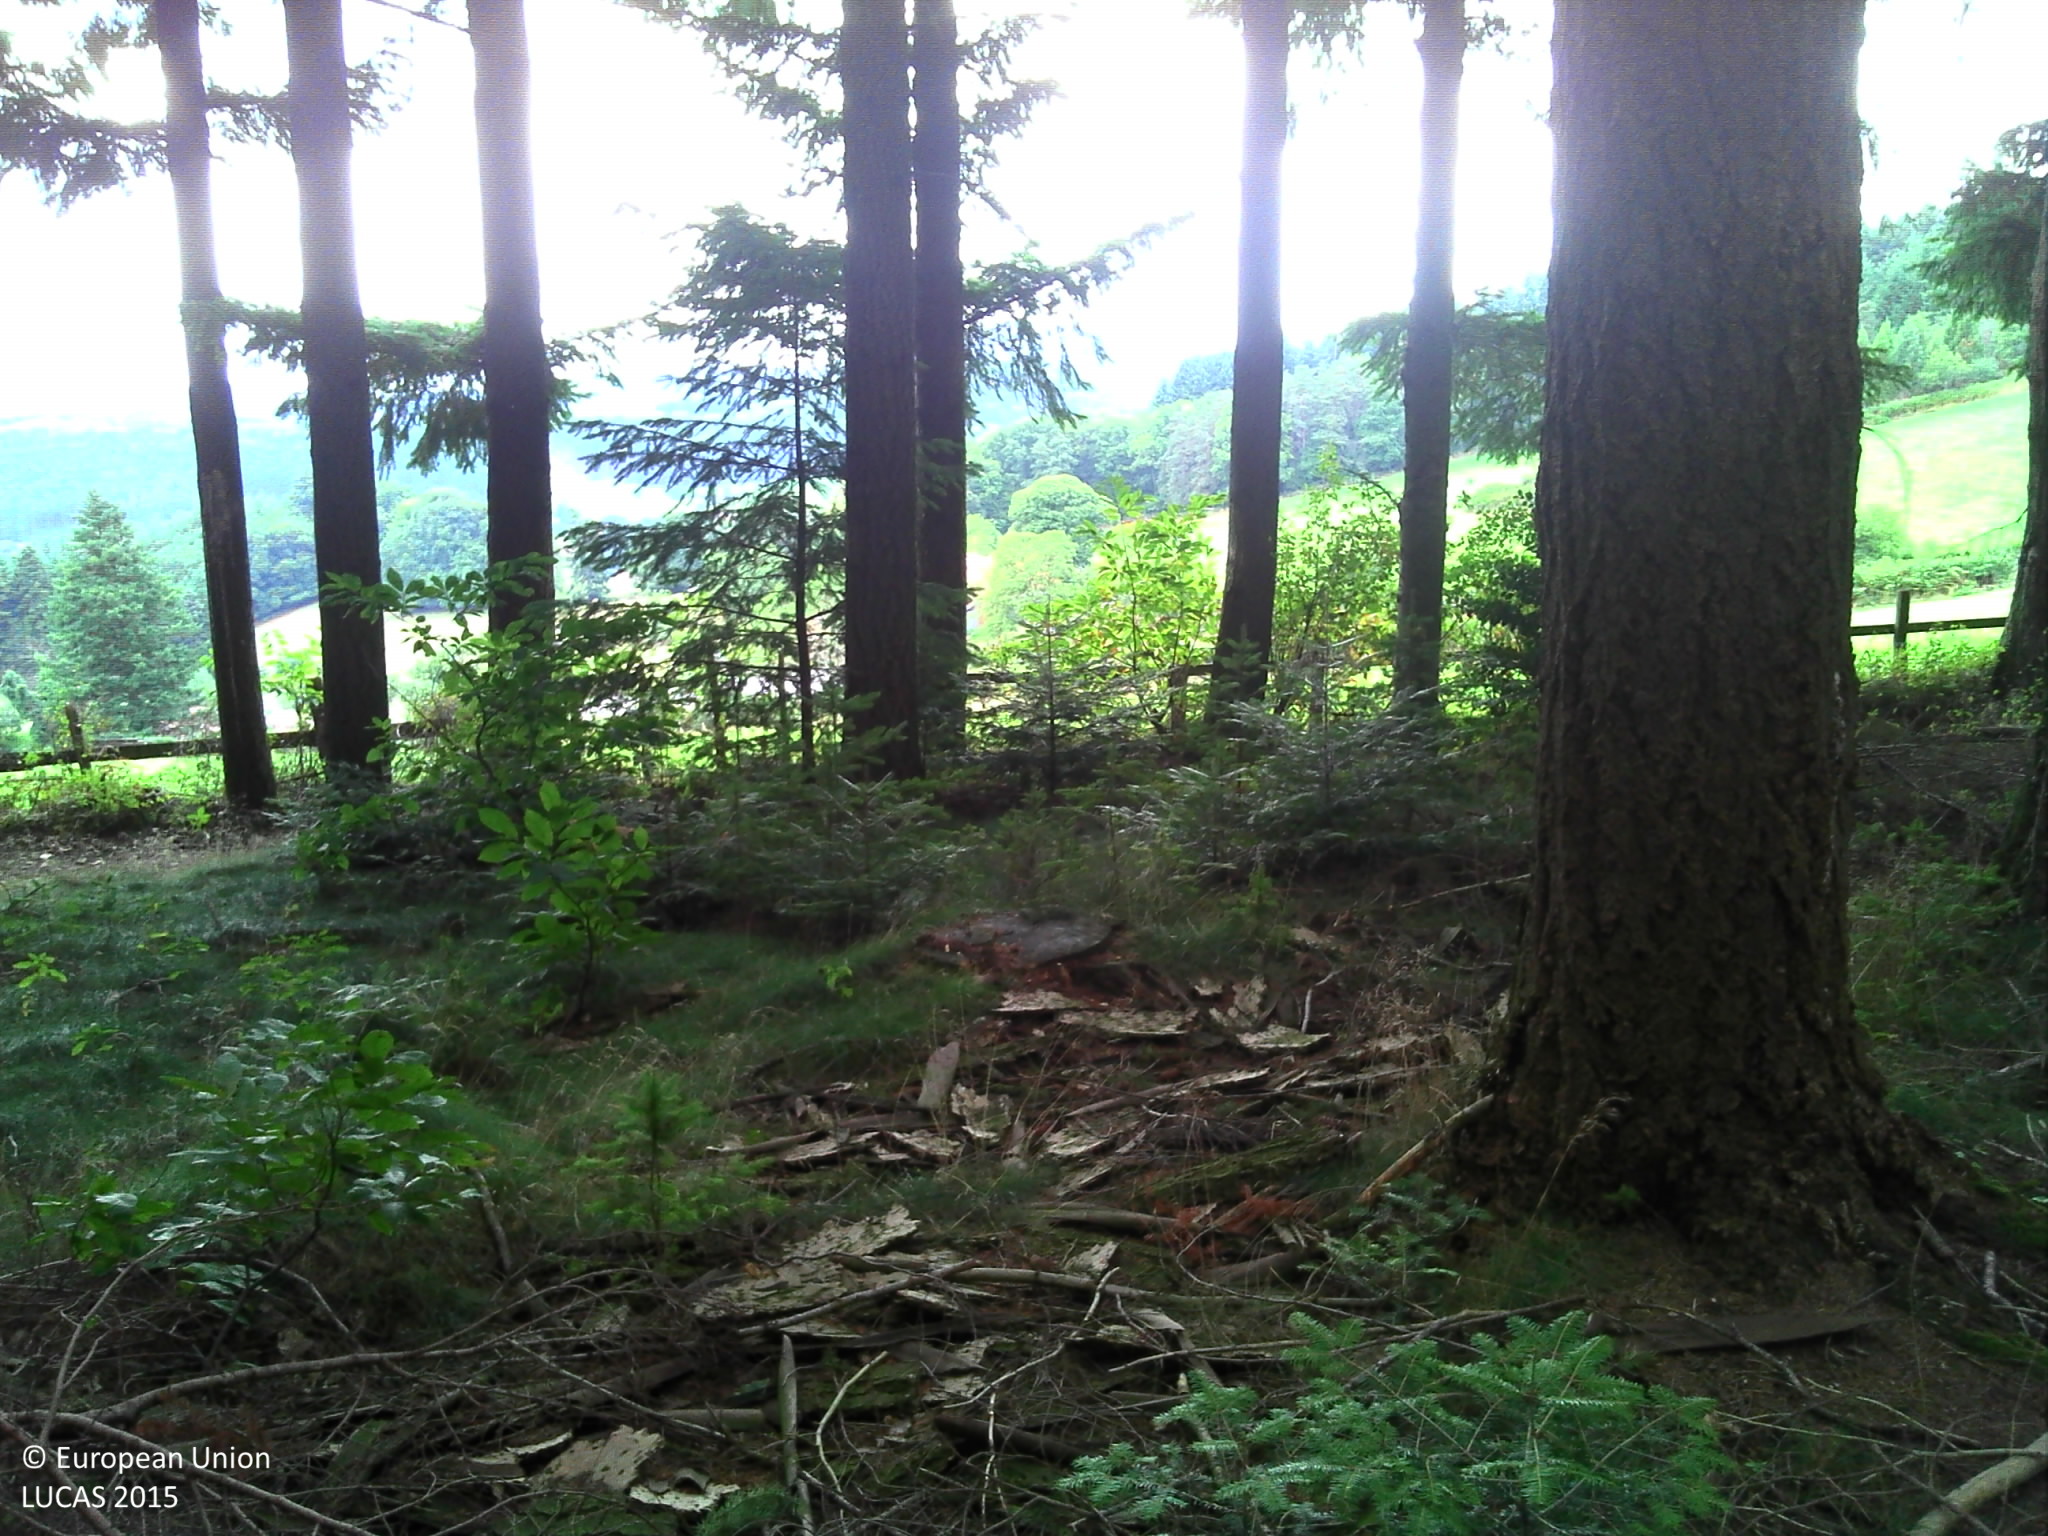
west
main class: Woodland
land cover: Spruce dominated coniferous woodland
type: exotic forest
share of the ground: > 75 %
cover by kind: coniferous forest trees 80 %, herbaceous plants 20 %
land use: Forestry
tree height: > 5 m
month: August
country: FR
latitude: 46.2606
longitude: 4.4362
